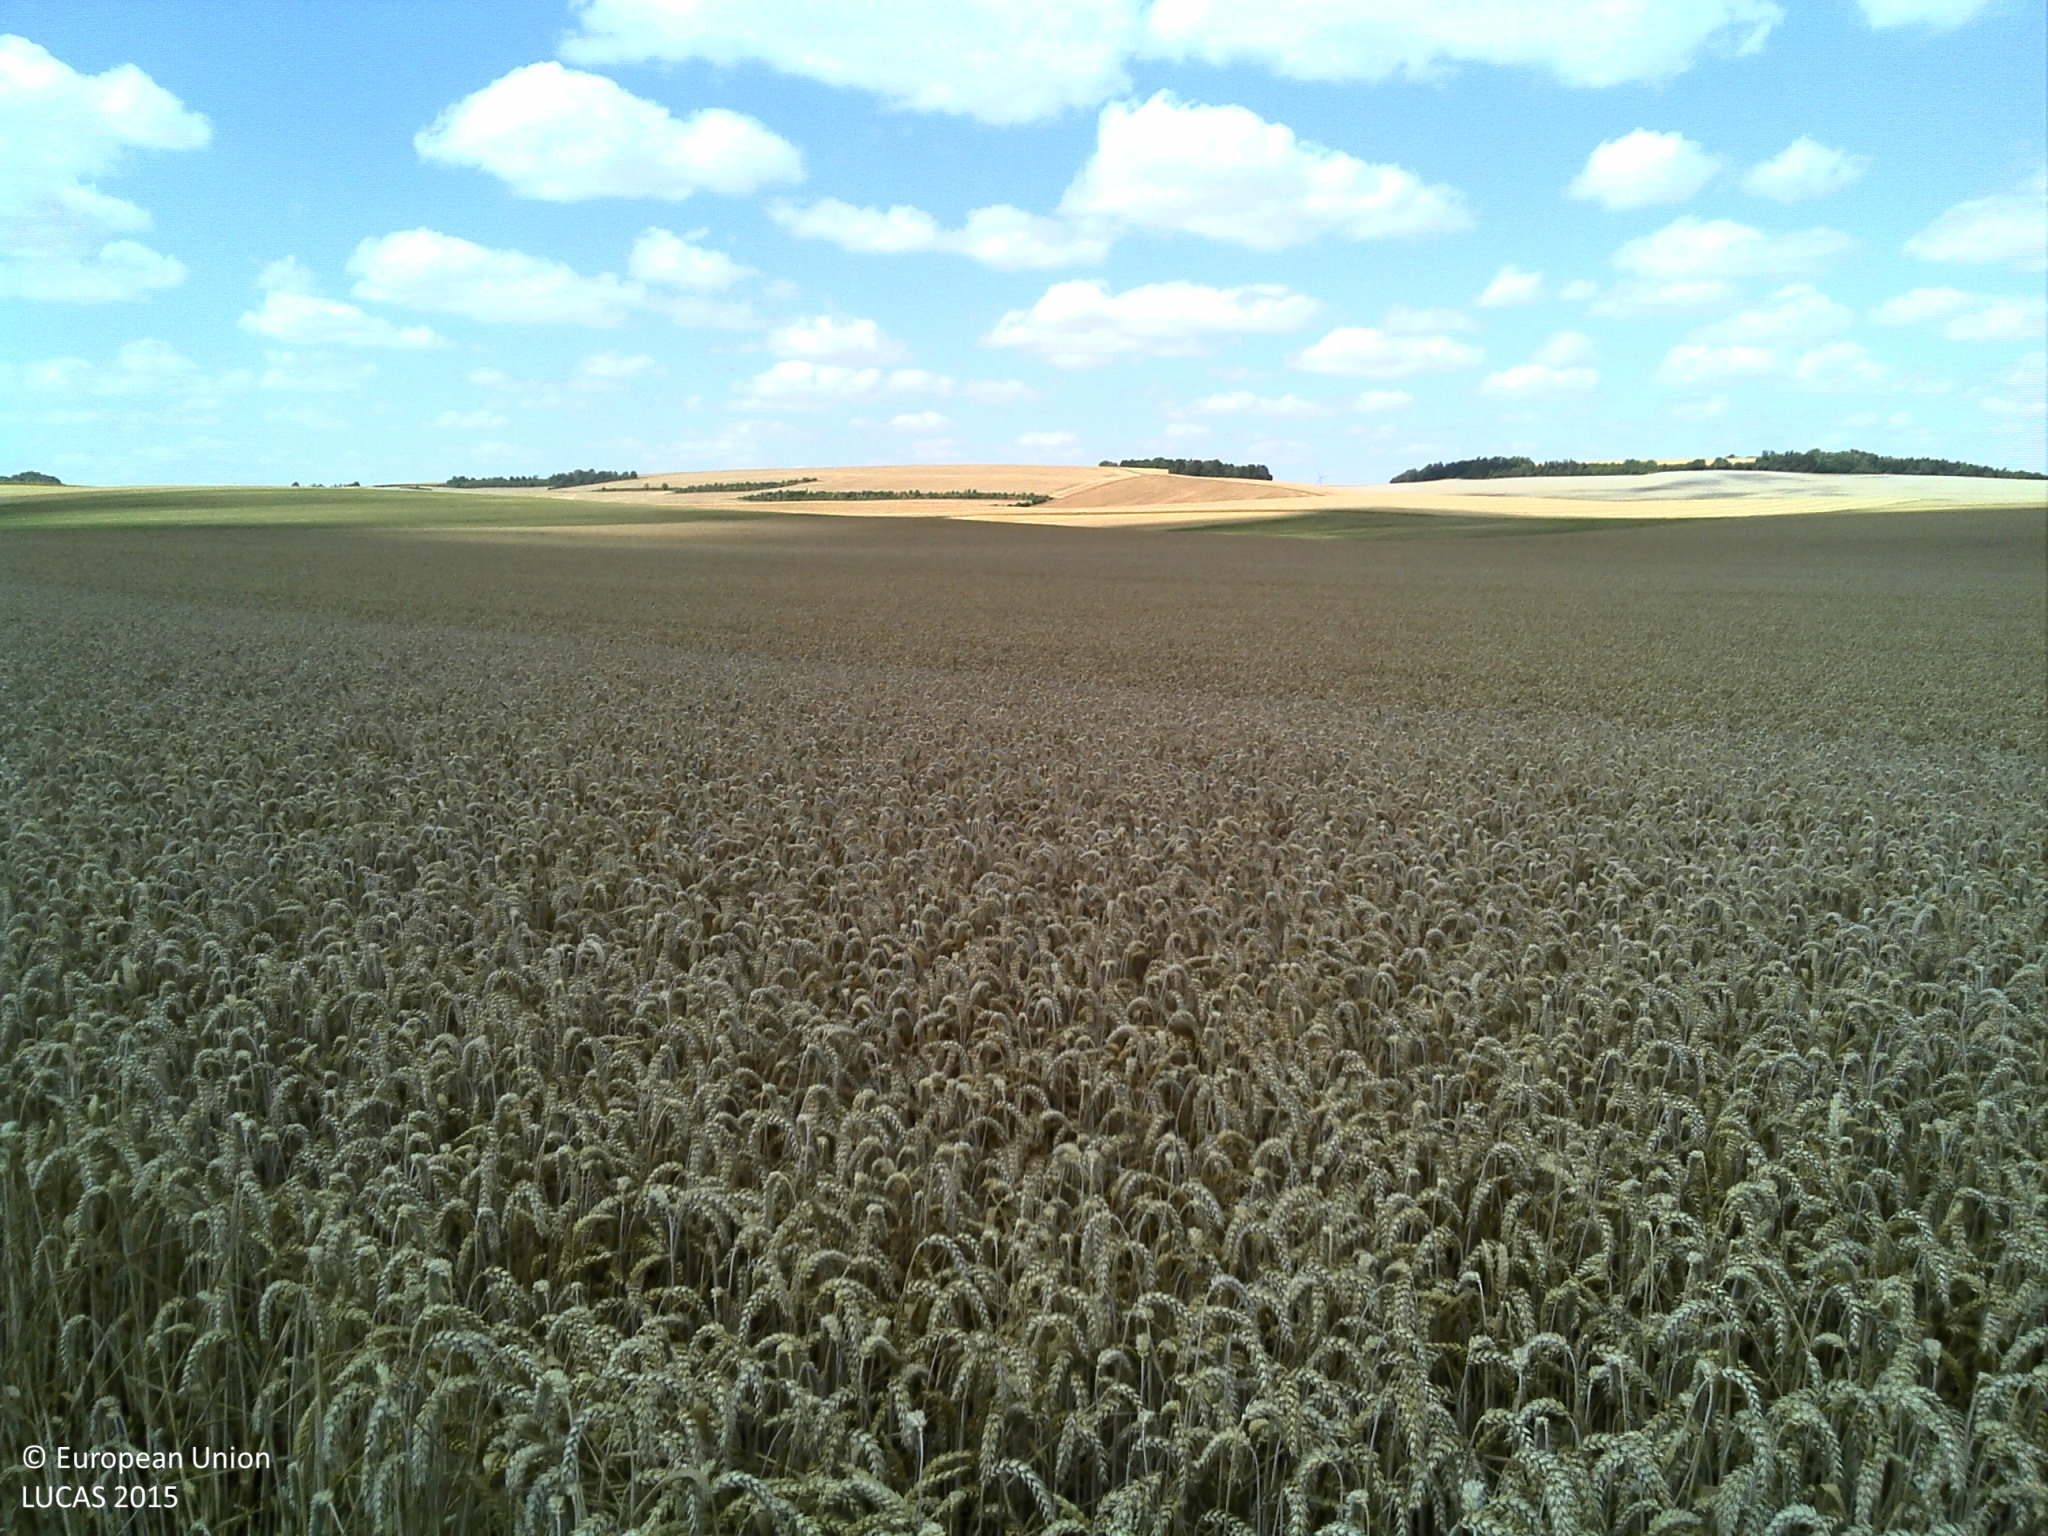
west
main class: Cropland
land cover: Common wheat
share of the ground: > 75 %
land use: Agriculture (excluding fallow land and kitchen gardens)
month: July
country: FR
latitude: 48.8378
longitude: 4.7520
